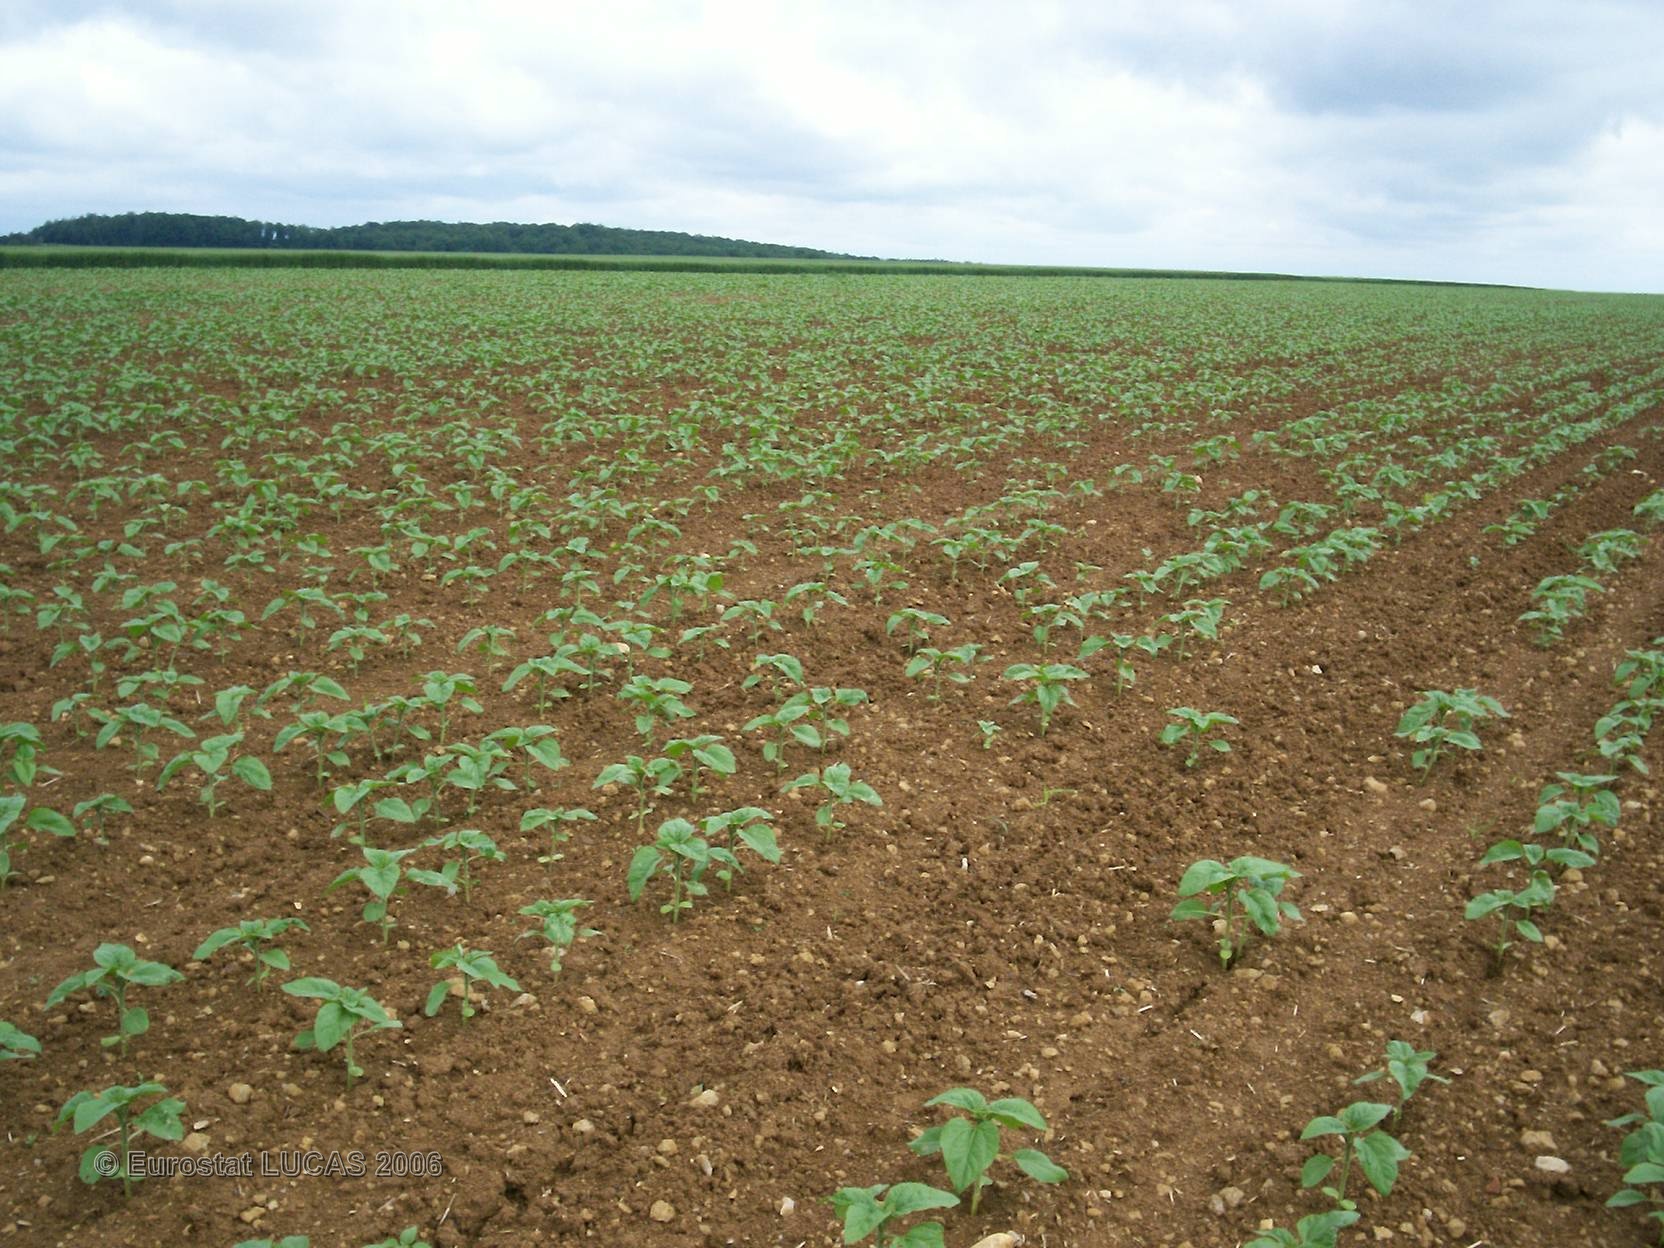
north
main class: Cropland
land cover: Sunflower
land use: Agriculture (excluding fallow land and kitchen gardens)
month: May
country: FR
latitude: 48.2687
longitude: 4.5413
